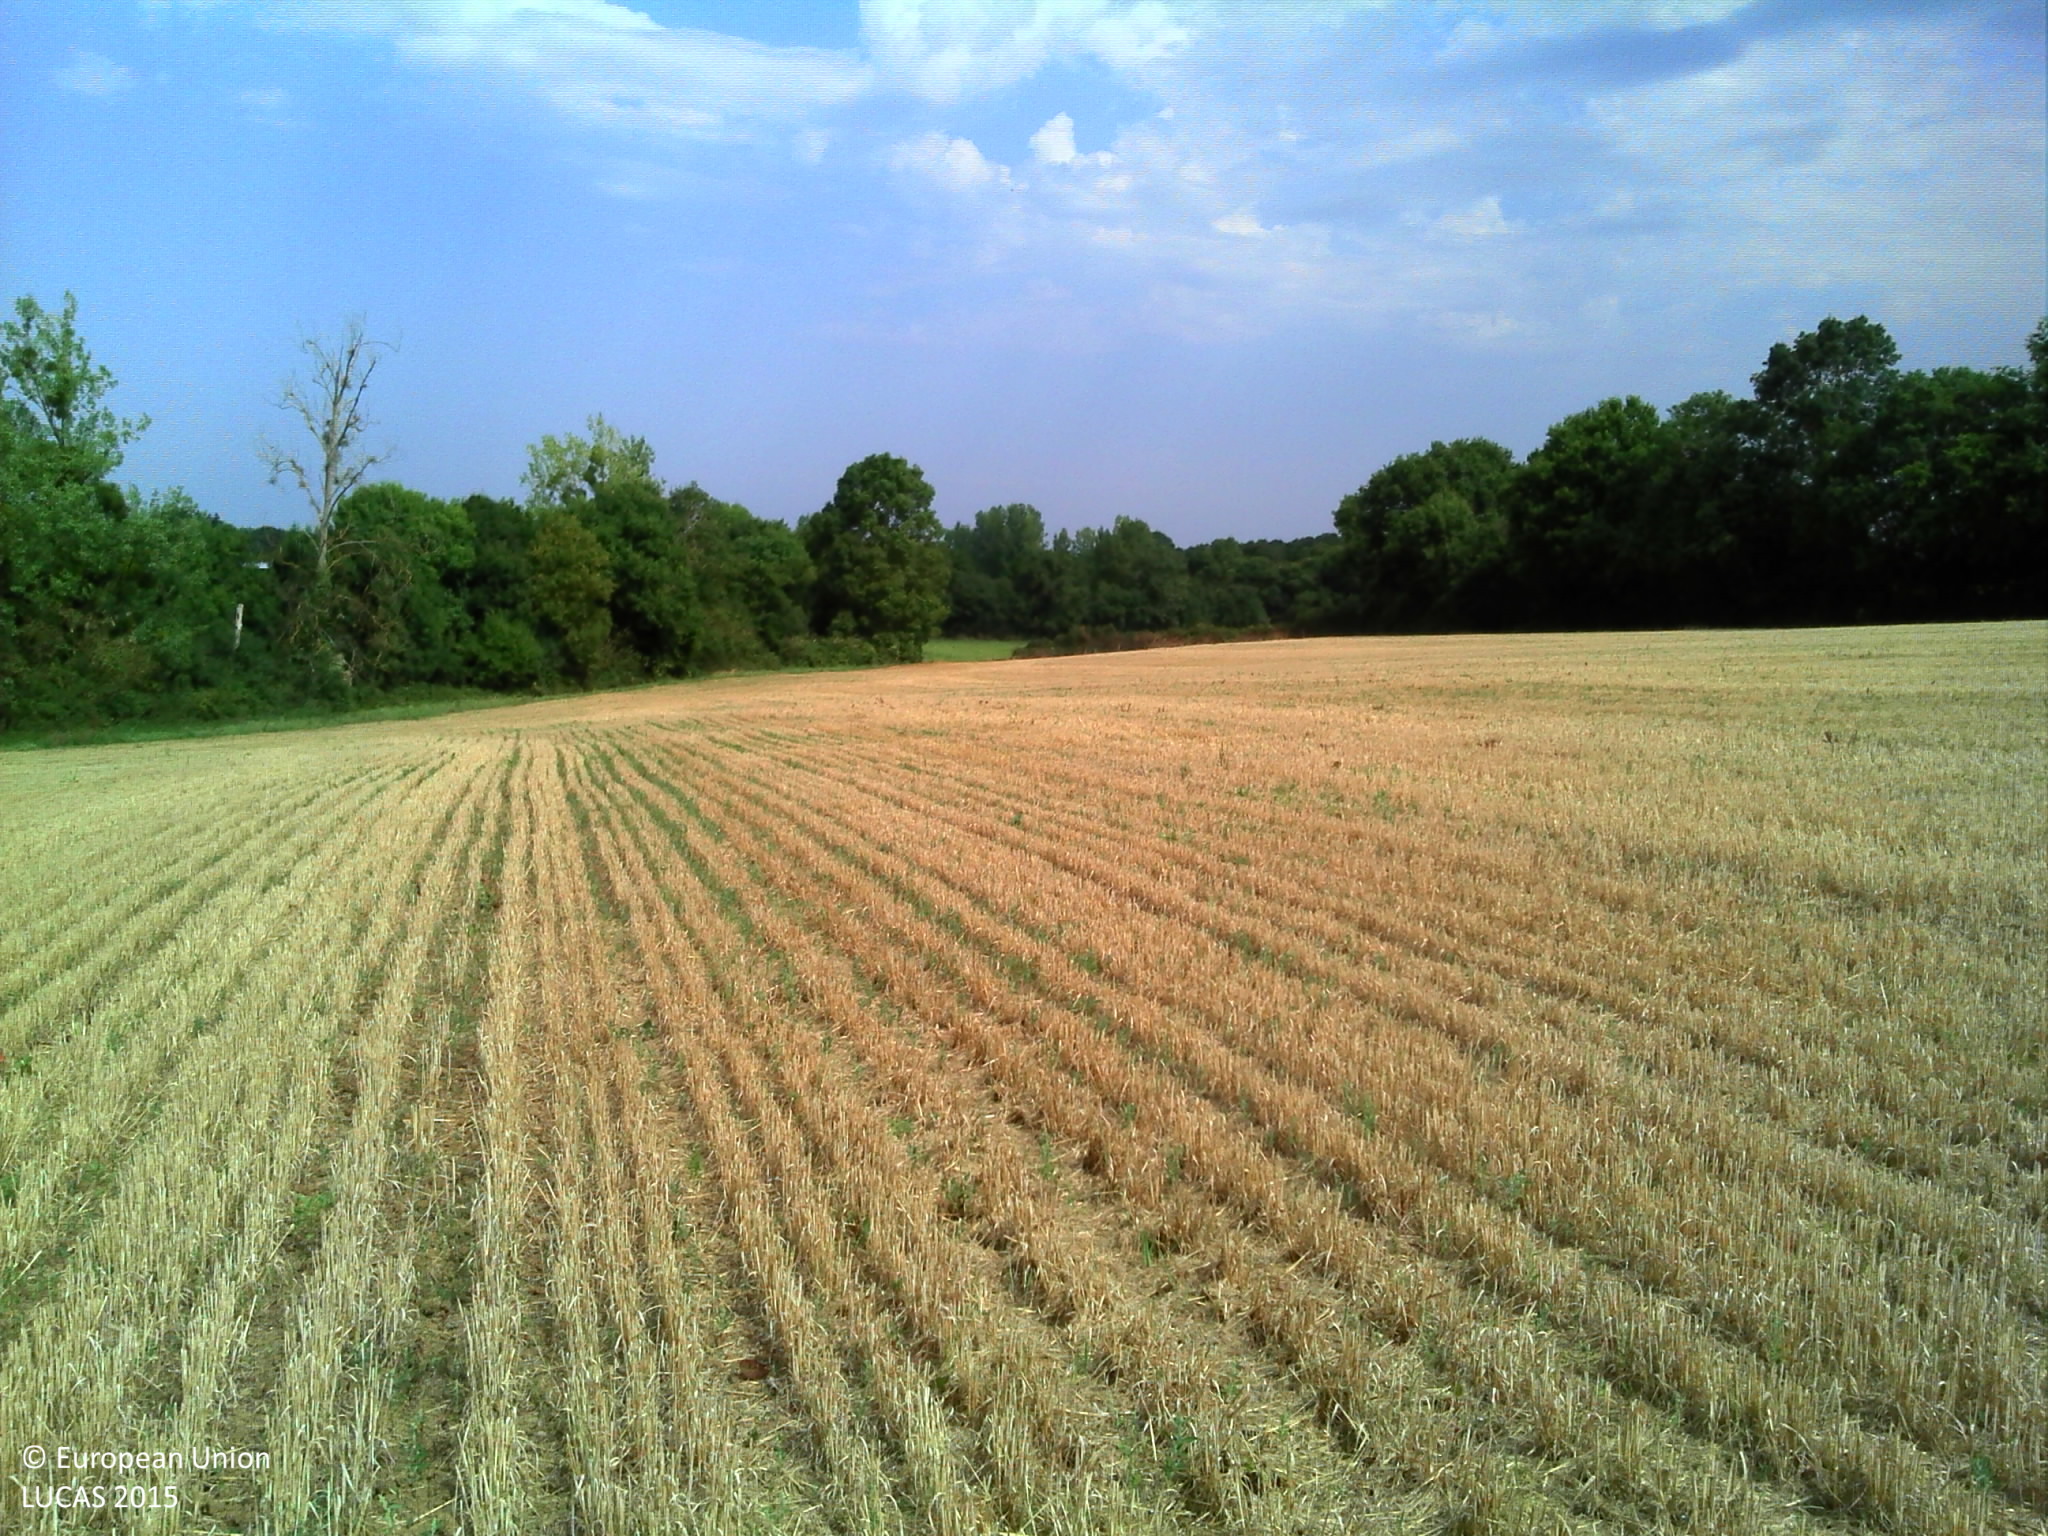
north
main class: Cropland
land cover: Barley
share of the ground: > 75 %
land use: Agriculture (excluding fallow land and kitchen gardens)
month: August
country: FR
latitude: 46.9515
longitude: -1.4576
